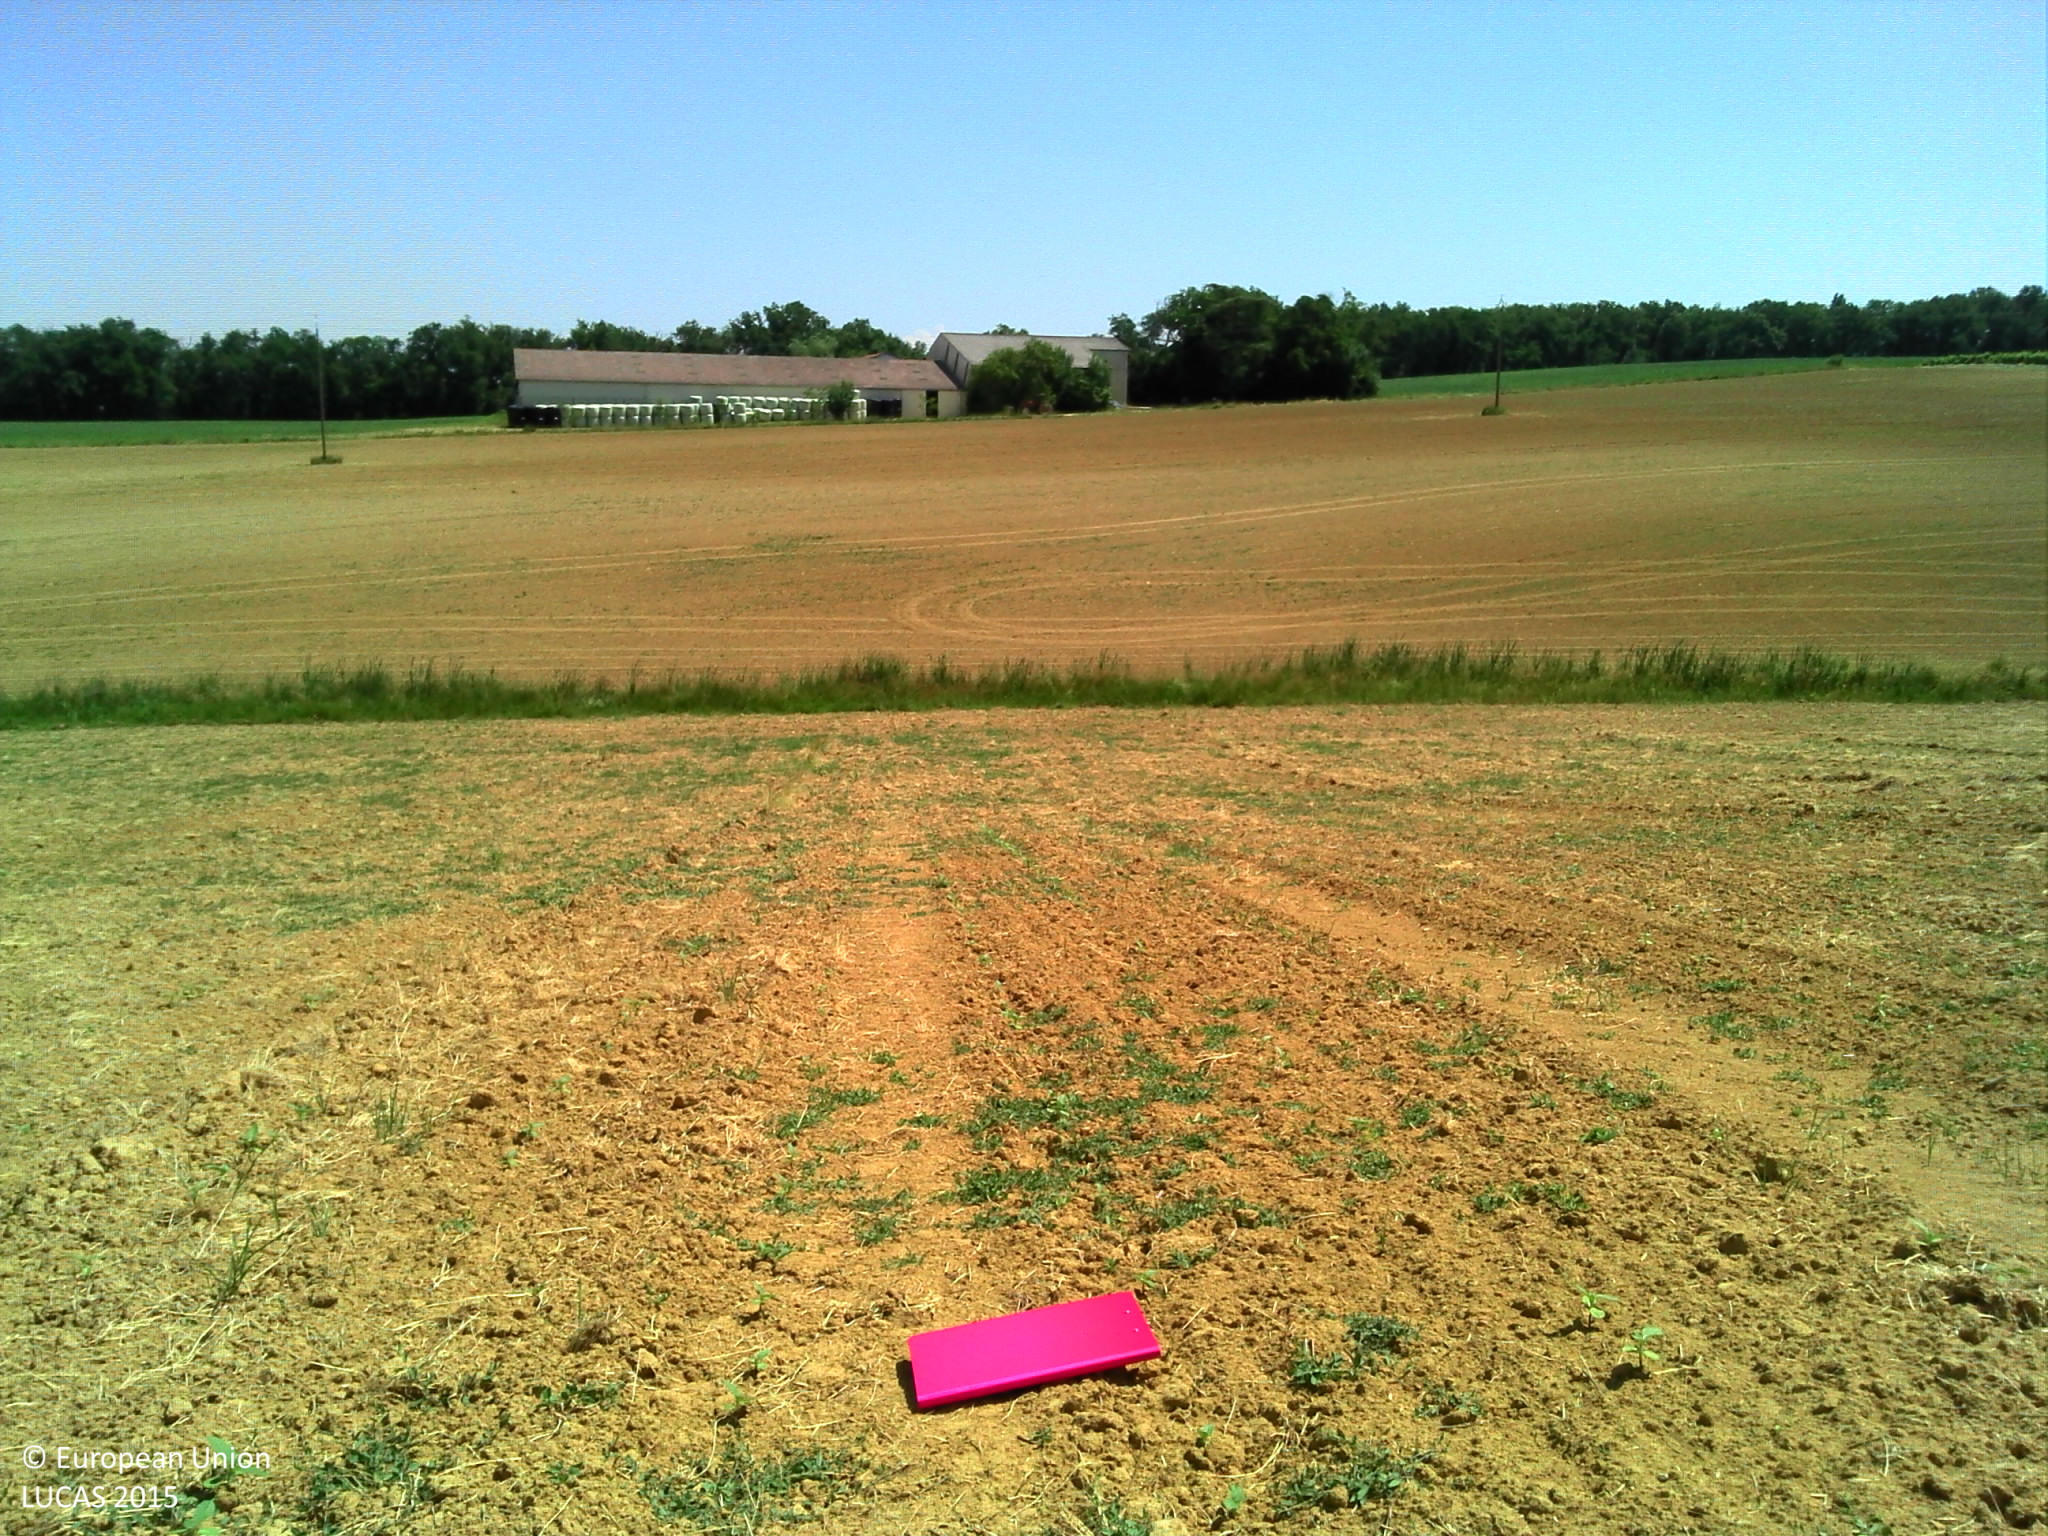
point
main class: Cropland
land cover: Sunflower
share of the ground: < 10 %
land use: Agriculture (excluding fallow land and kitchen gardens)
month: June
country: FR
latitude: 43.7302
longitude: 0.6743
